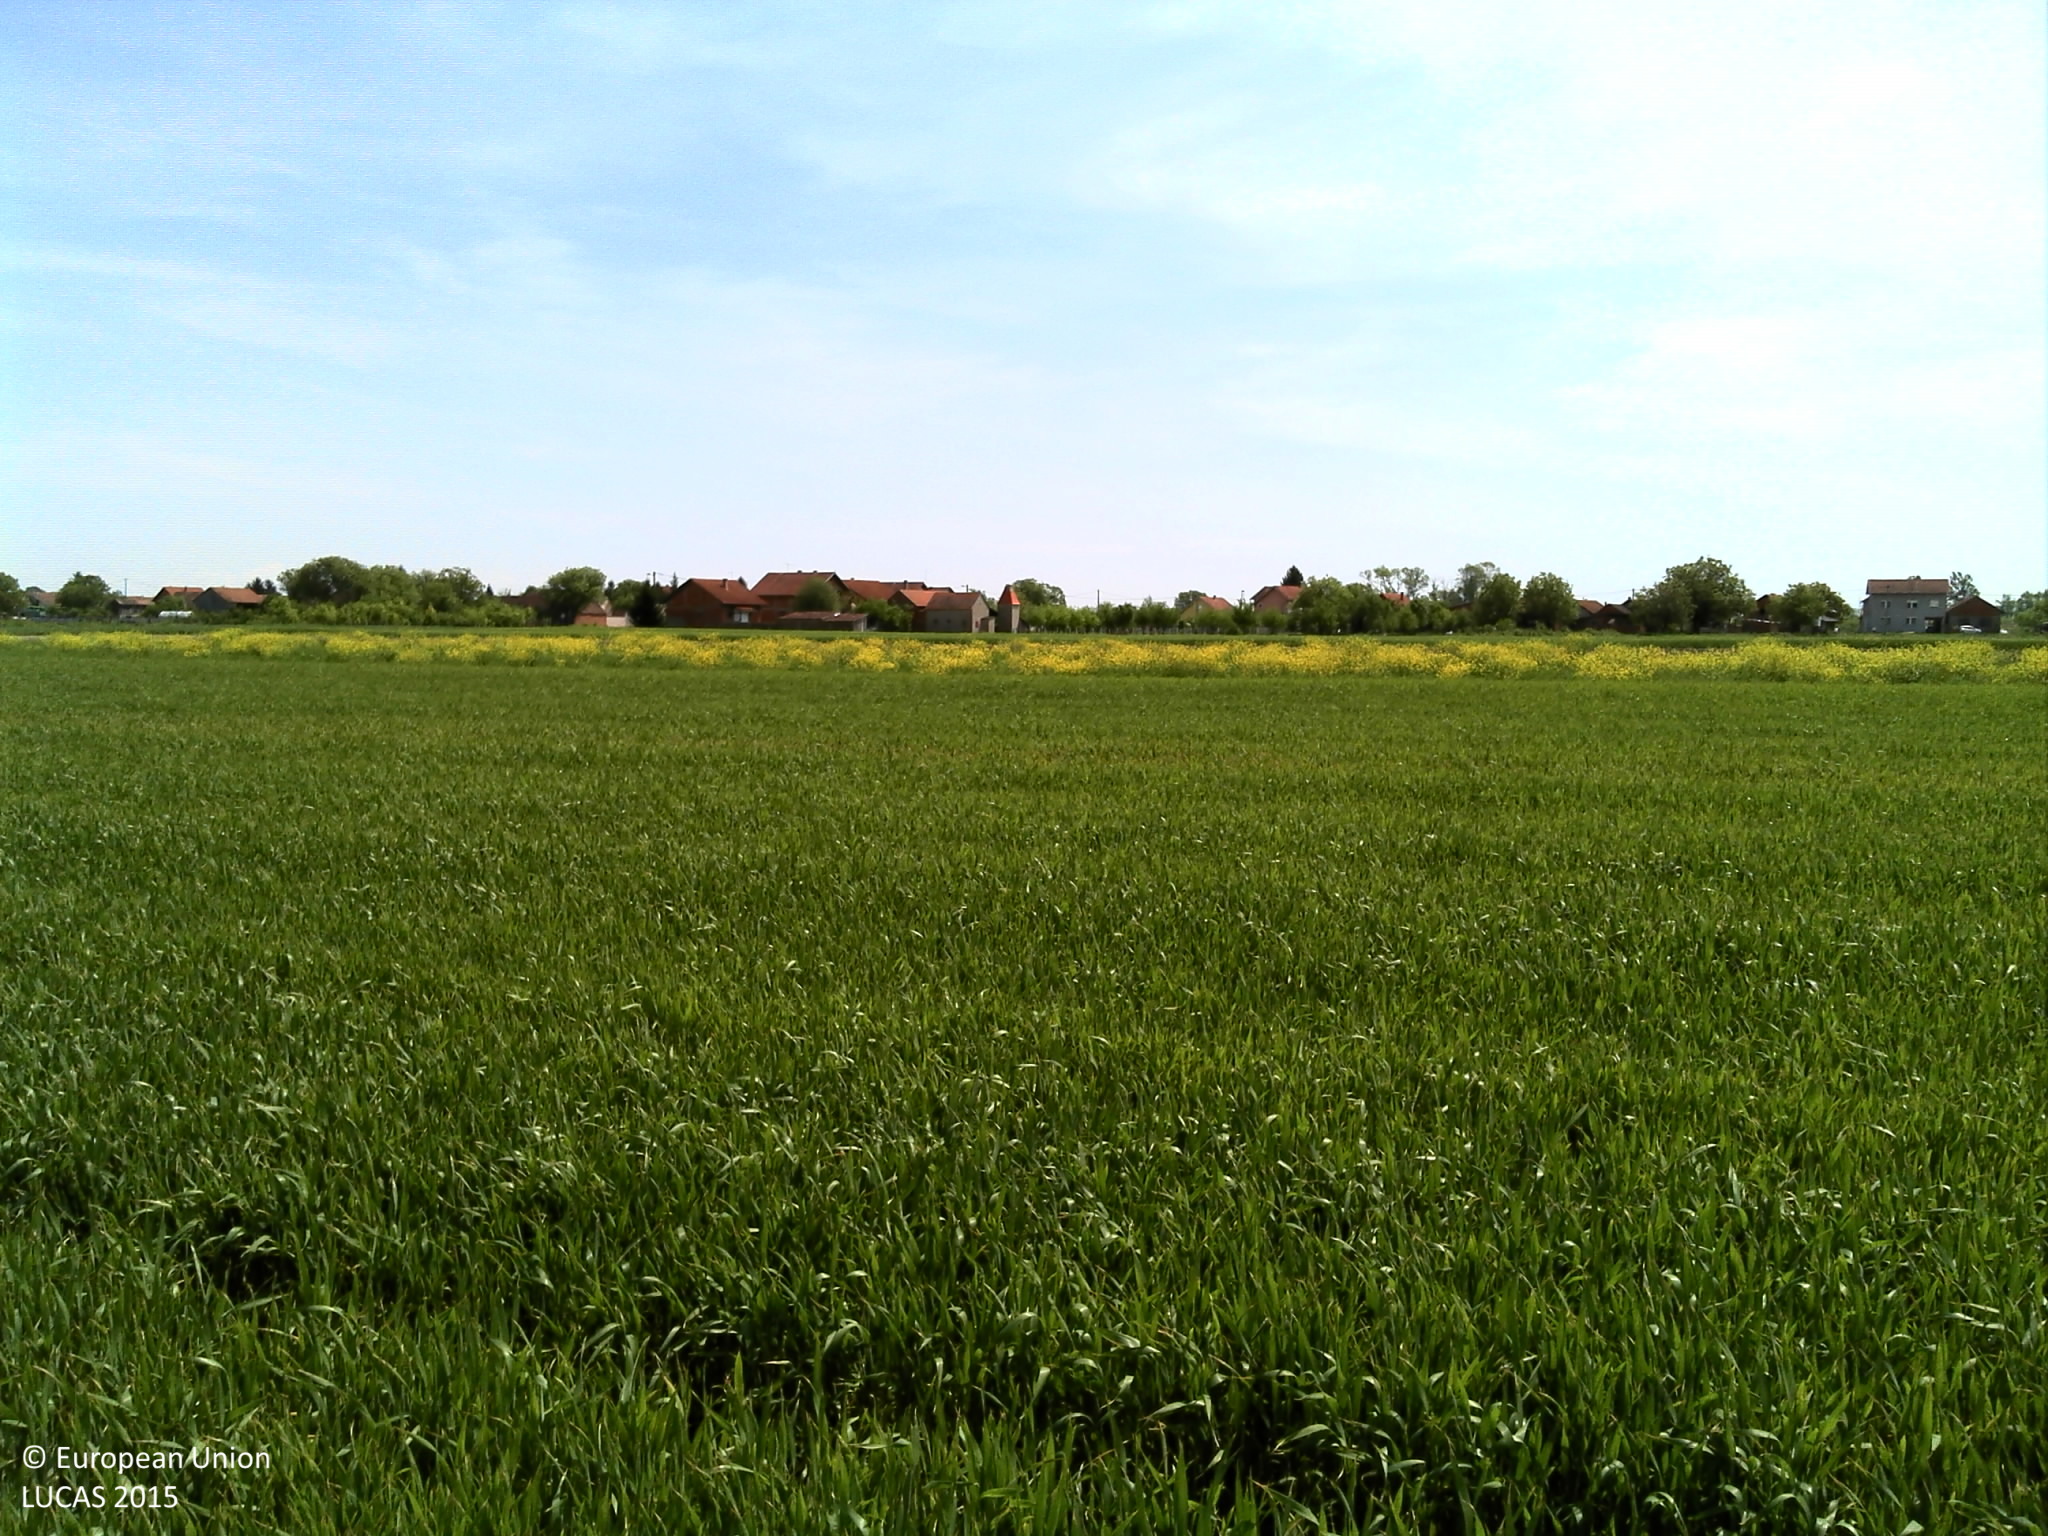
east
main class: Cropland
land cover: Common wheat
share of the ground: > 75 %
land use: Agriculture (excluding fallow land and kitchen gardens)
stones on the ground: < 10 %
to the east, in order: Common wheat; Clovers; Maize; Barley; Common wheat
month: May
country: HR
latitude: 45.2378
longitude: 18.8864
